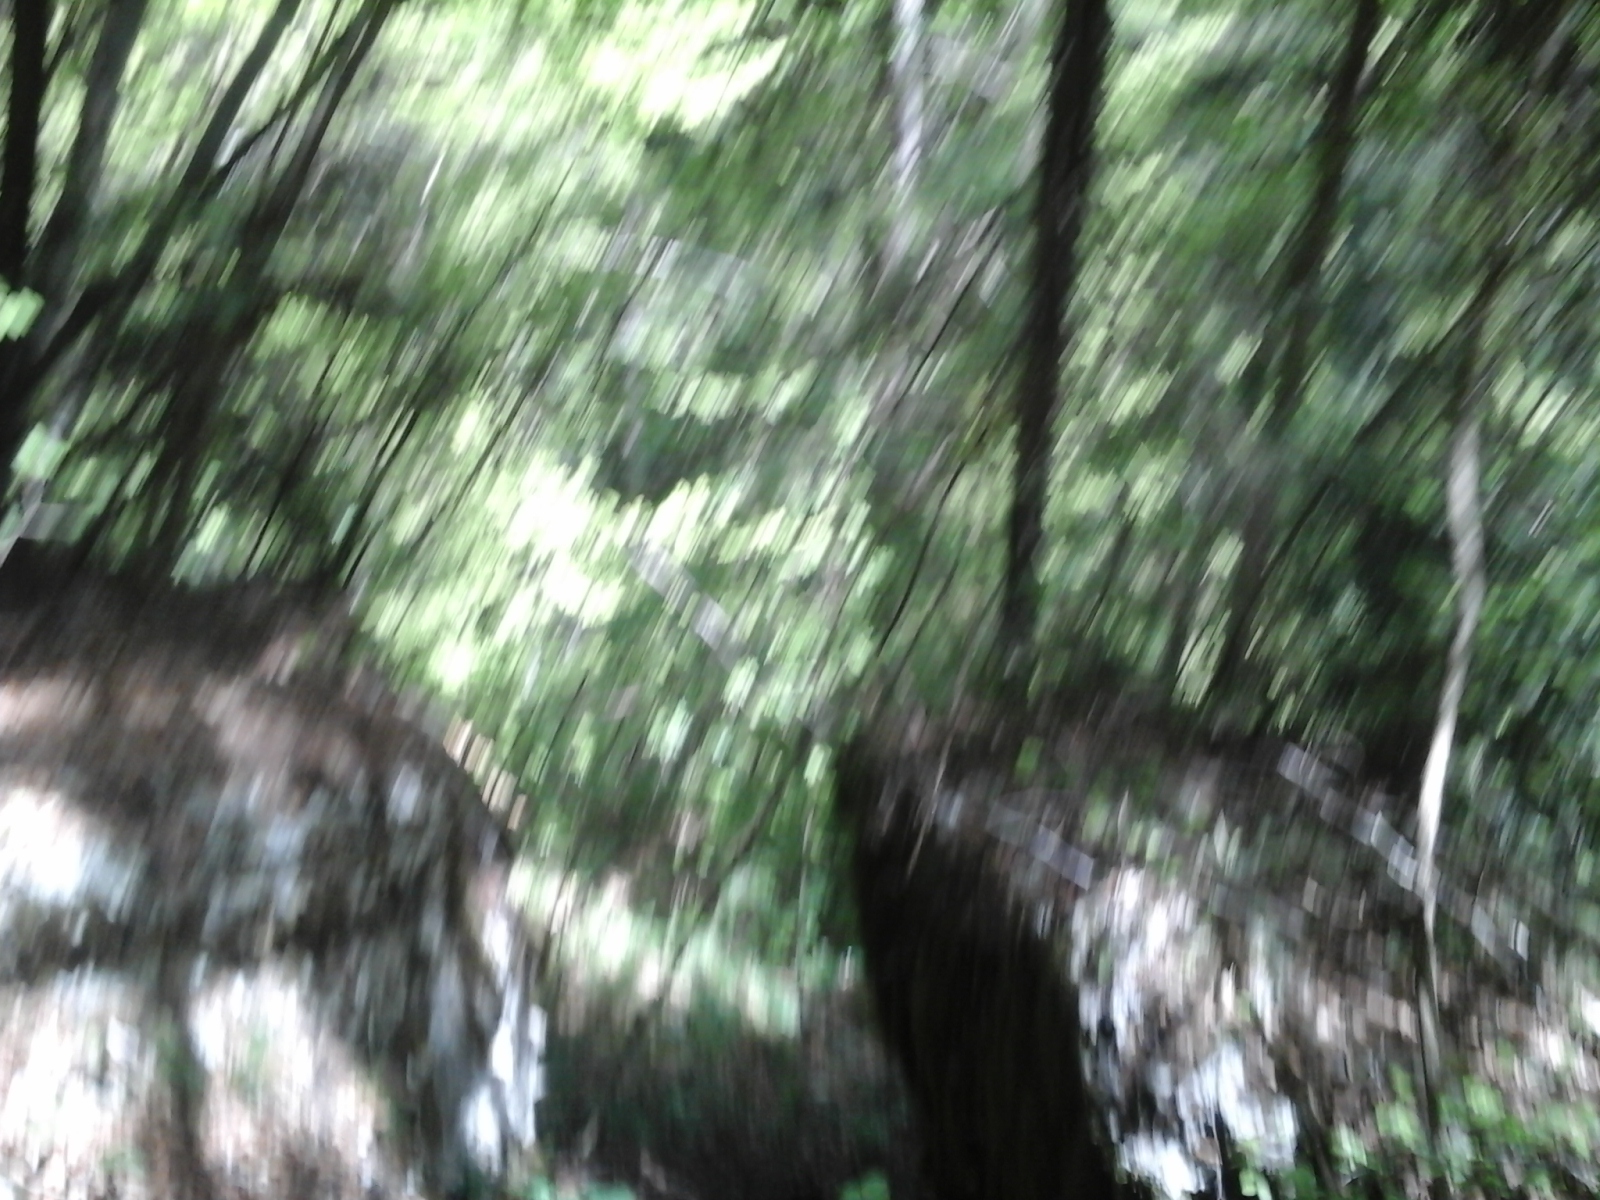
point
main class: Woodland
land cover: Spruce dominated mixed woodland
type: alpine coniferous forest
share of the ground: > 75 %
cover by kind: coniferous forest trees 75 %, broadleaved forest trees 25 %
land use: Forestry
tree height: > 5 m
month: May
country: IT
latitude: 45.8988
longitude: 10.6563
